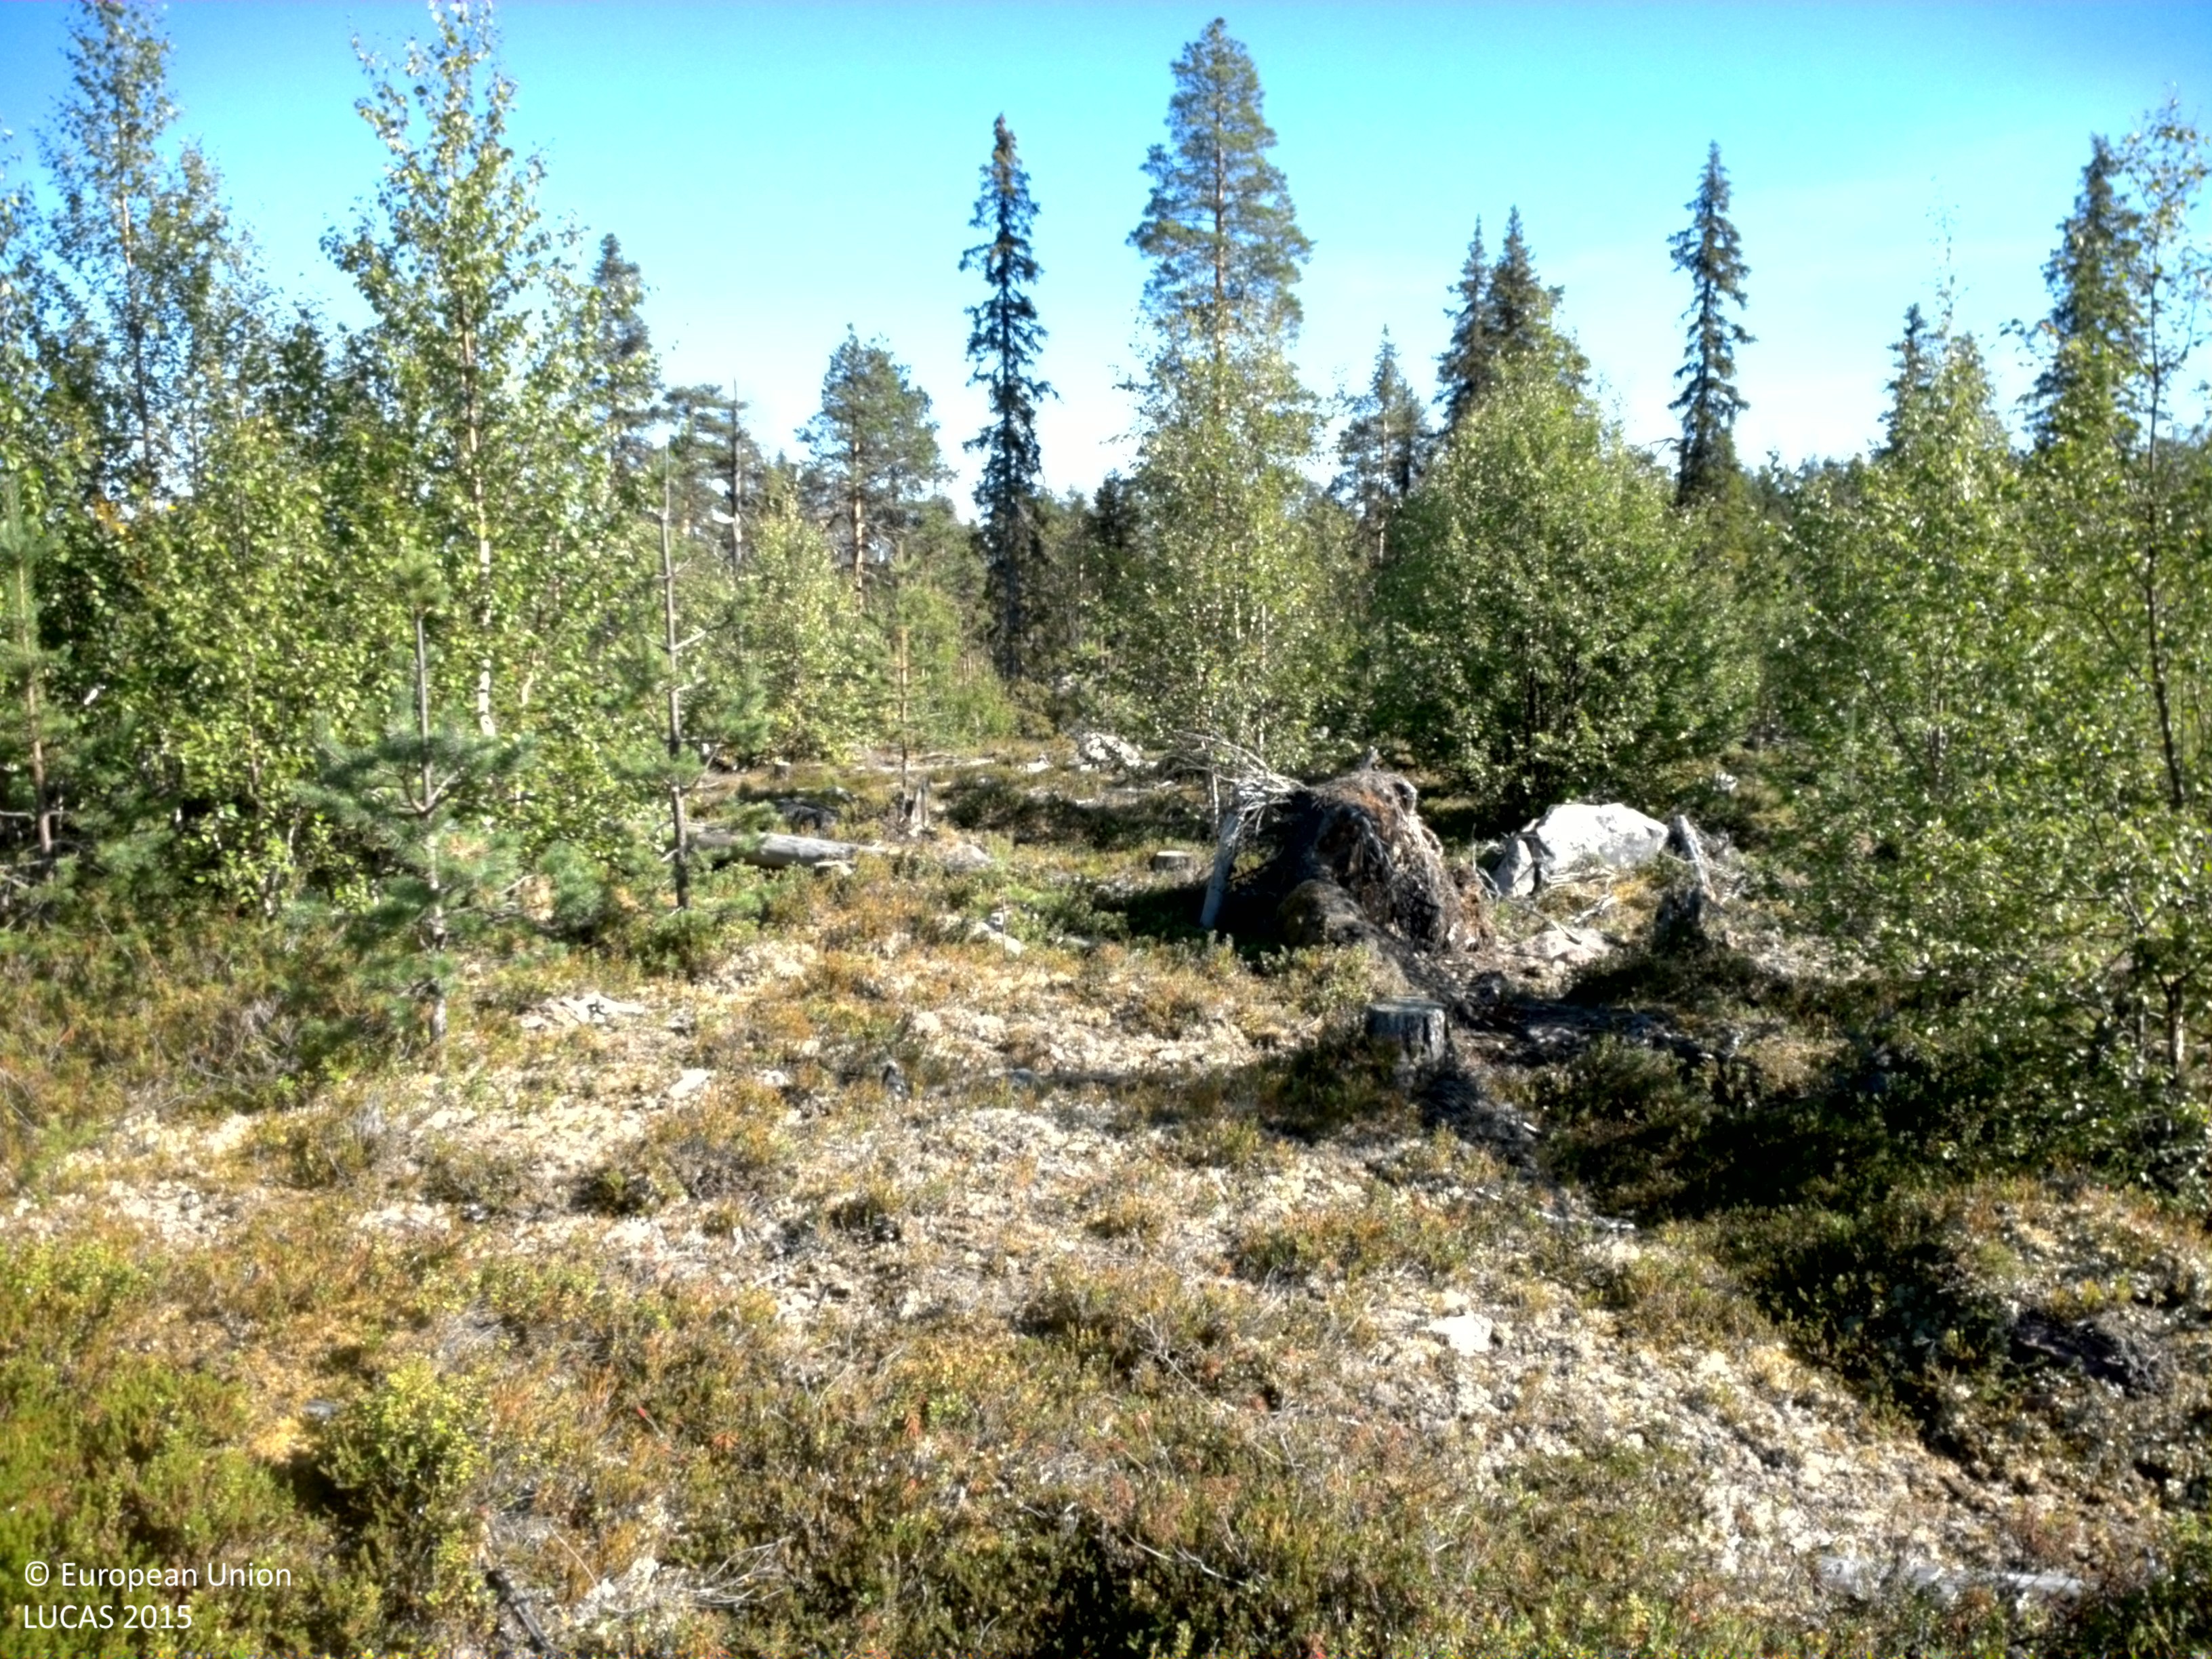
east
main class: Woodland
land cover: Pine dominated mixed woodland
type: boreal forest
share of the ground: 25 - 50 %
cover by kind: shrubs 55 %, broadleaved forest trees 20 %, coniferous forest trees 10 %, lichens and mosses 10 %, consolidated bare surface 5 %
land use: Forestry
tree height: < 5 m
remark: Clear cut
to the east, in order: Pine dominated mixed woodland; Inland marshes; Pine dominated coniferous woodland; Shrubland with sparse tree cover; Broadleaved woodland
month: August
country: SE
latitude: 66.8101
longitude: 18.8464
